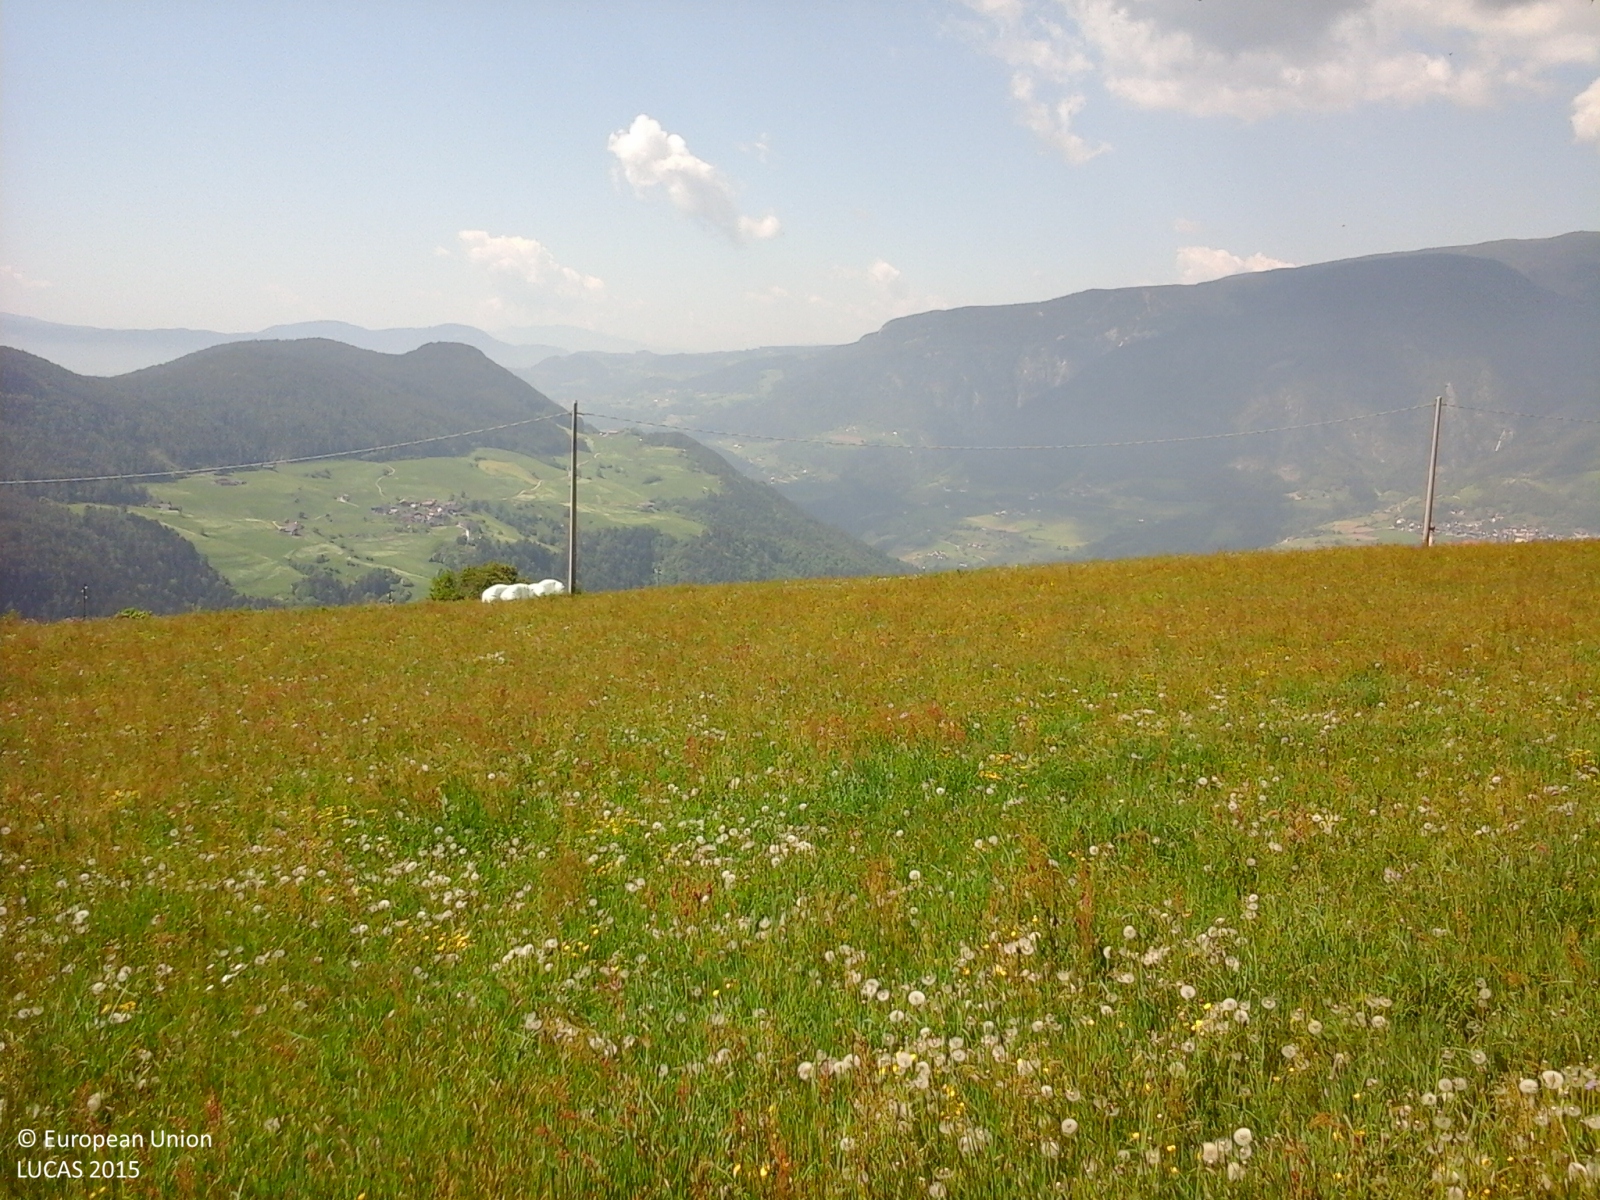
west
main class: Grassland
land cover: Grassland without tree/shrub cover
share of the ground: > 75 %
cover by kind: herbaceous plants 100 %
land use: Agriculture (excluding fallow land and kitchen gardens)
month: May
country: IT
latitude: 46.6098
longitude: 11.5780
